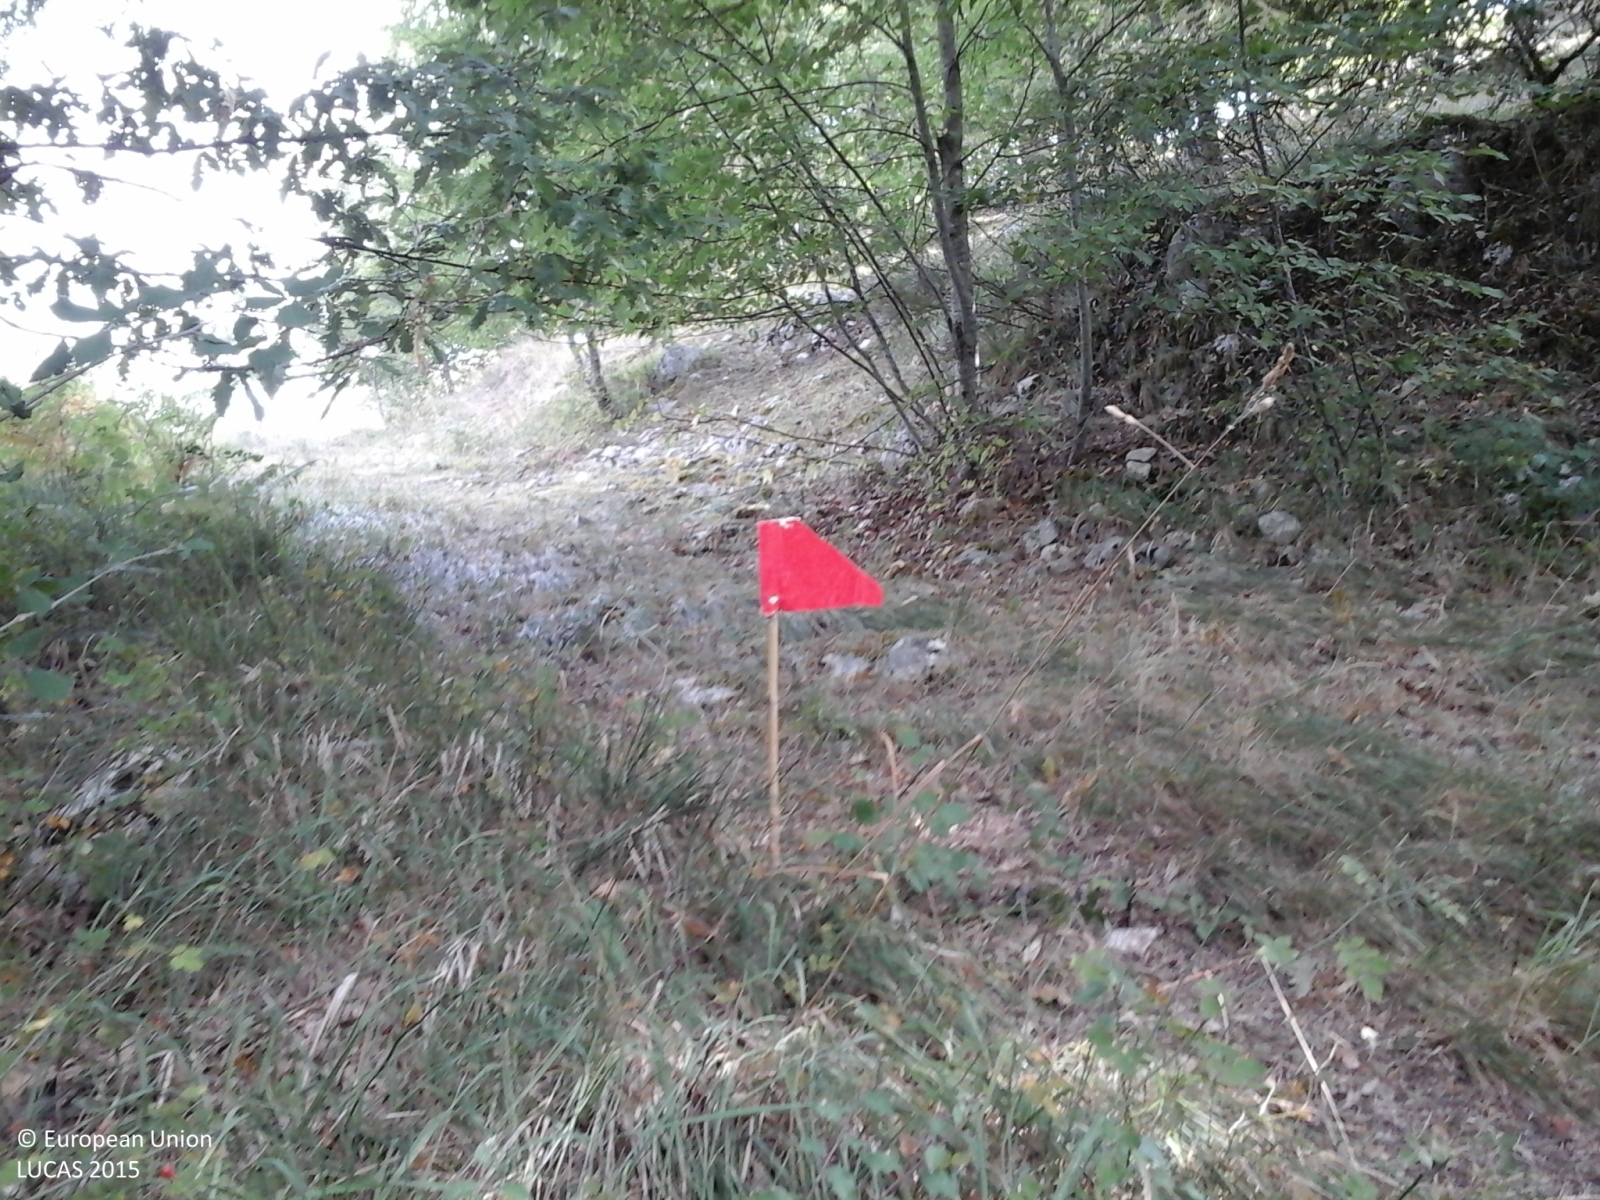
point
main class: Woodland
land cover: Broadleaved woodland
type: thermophilous deciduous forest
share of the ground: > 75 %
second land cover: Grassland without tree/shrub cover
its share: > 75 %
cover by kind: broadleaved forest trees 80 %, herbaceous plants 15 %, shrubs 5 %
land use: Forestry
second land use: Agriculture (excluding fallow land and kitchen gardens)
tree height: > 5 m
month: September
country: IT
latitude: 41.6604
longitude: 14.2483
